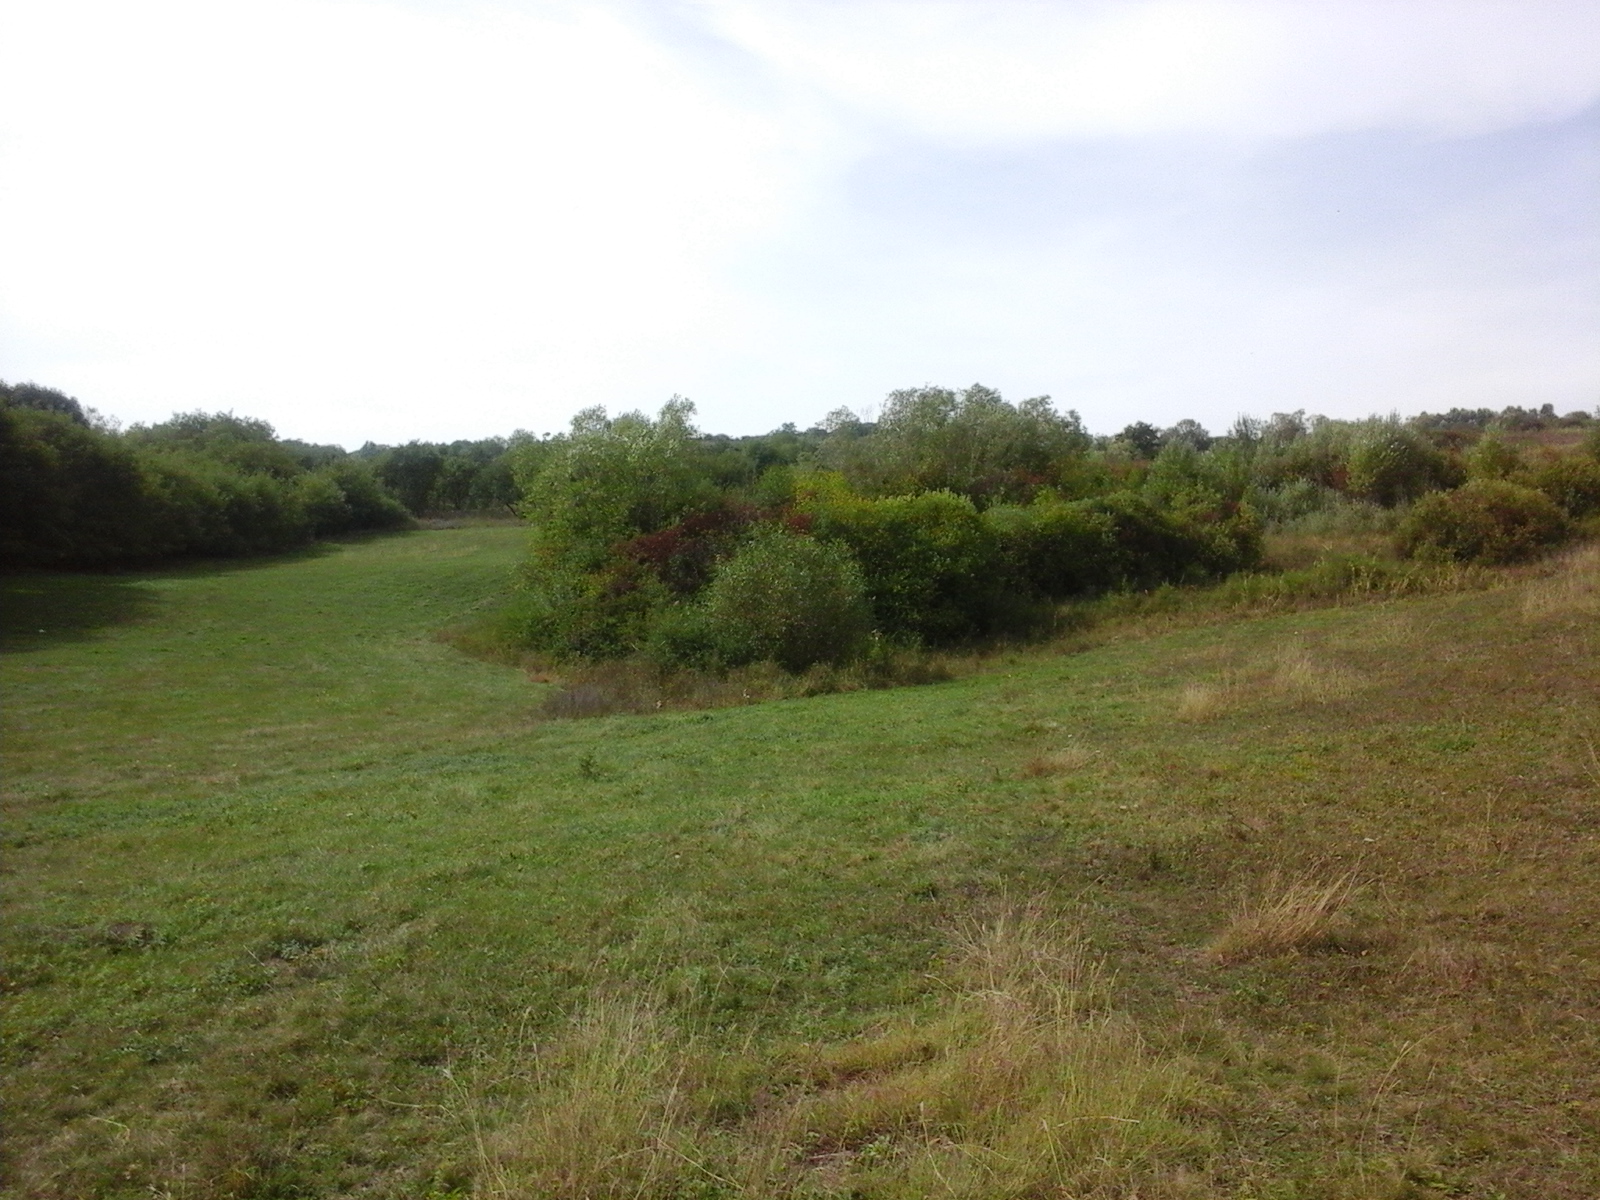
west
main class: Grassland
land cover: Grassland without tree/shrub cover
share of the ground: > 75 %
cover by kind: herbaceous plants 100 %
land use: Agriculture (excluding fallow land and kitchen gardens)
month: September
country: RO
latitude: 46.9144
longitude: 24.0645
